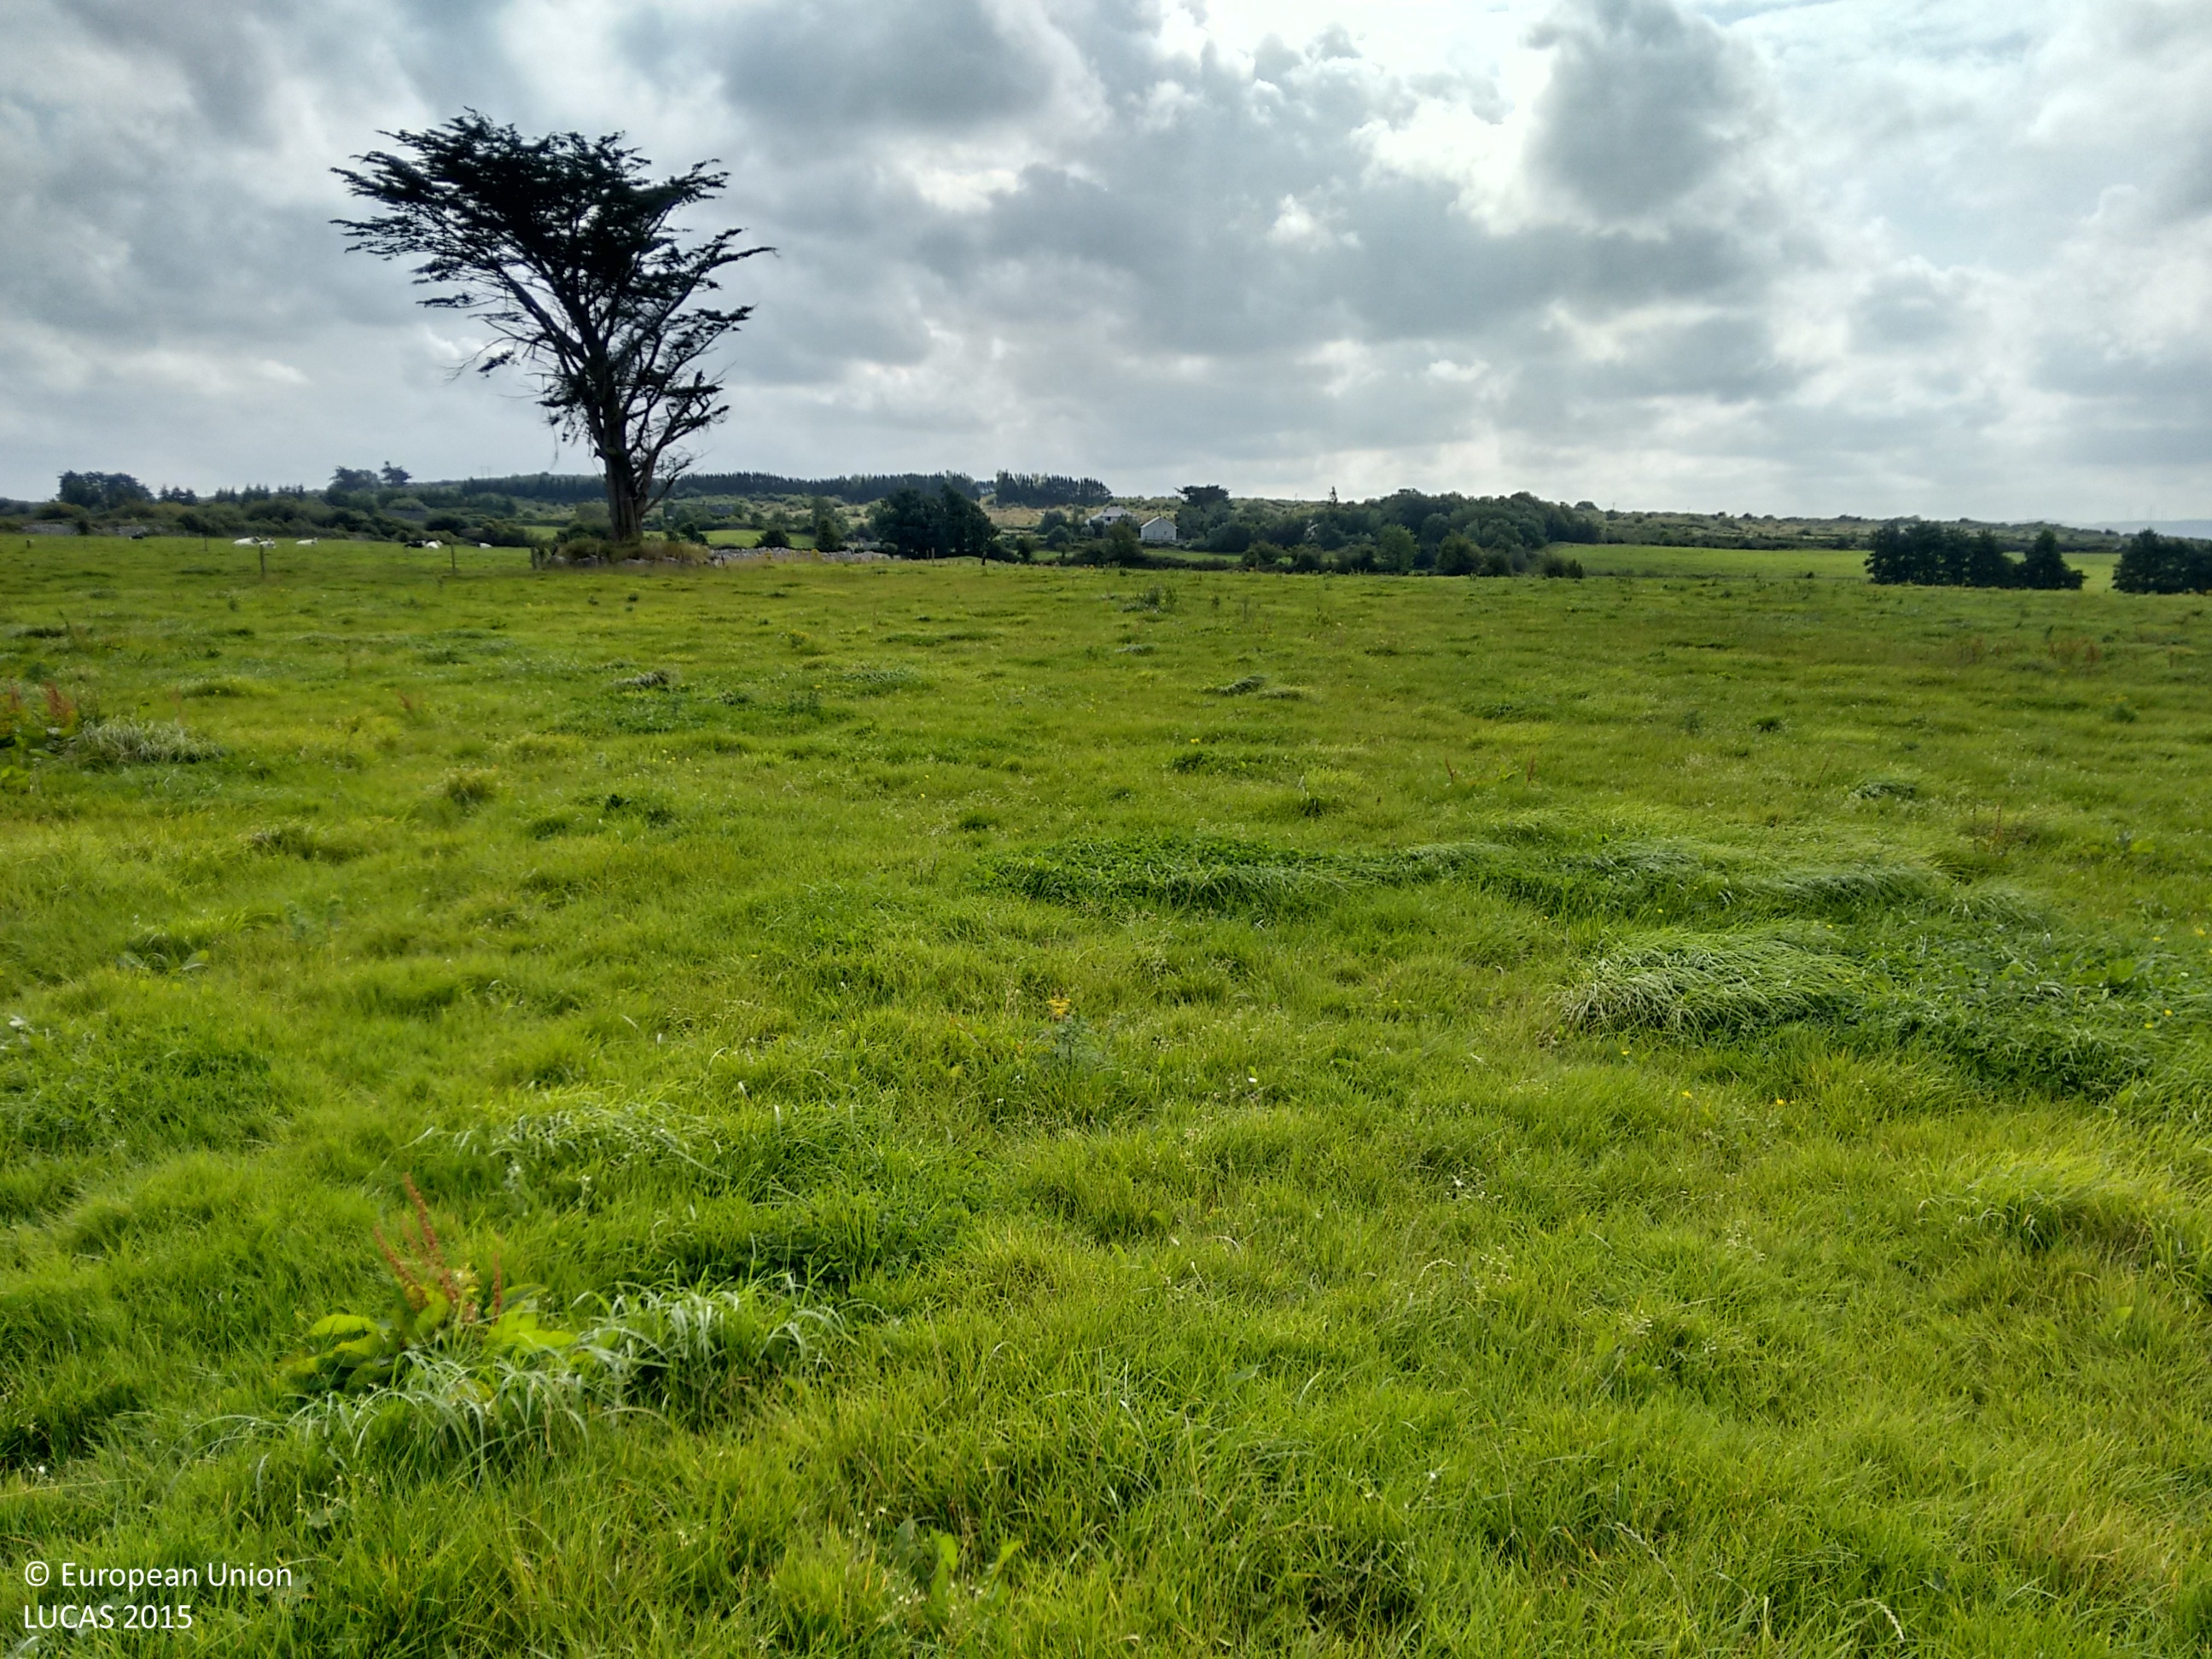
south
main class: Grassland
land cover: Grassland without tree/shrub cover
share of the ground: > 75 %
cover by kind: herbaceous plants 100 %
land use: Agriculture (excluding fallow land and kitchen gardens)
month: September
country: IE
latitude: 52.6095
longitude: -9.0433
